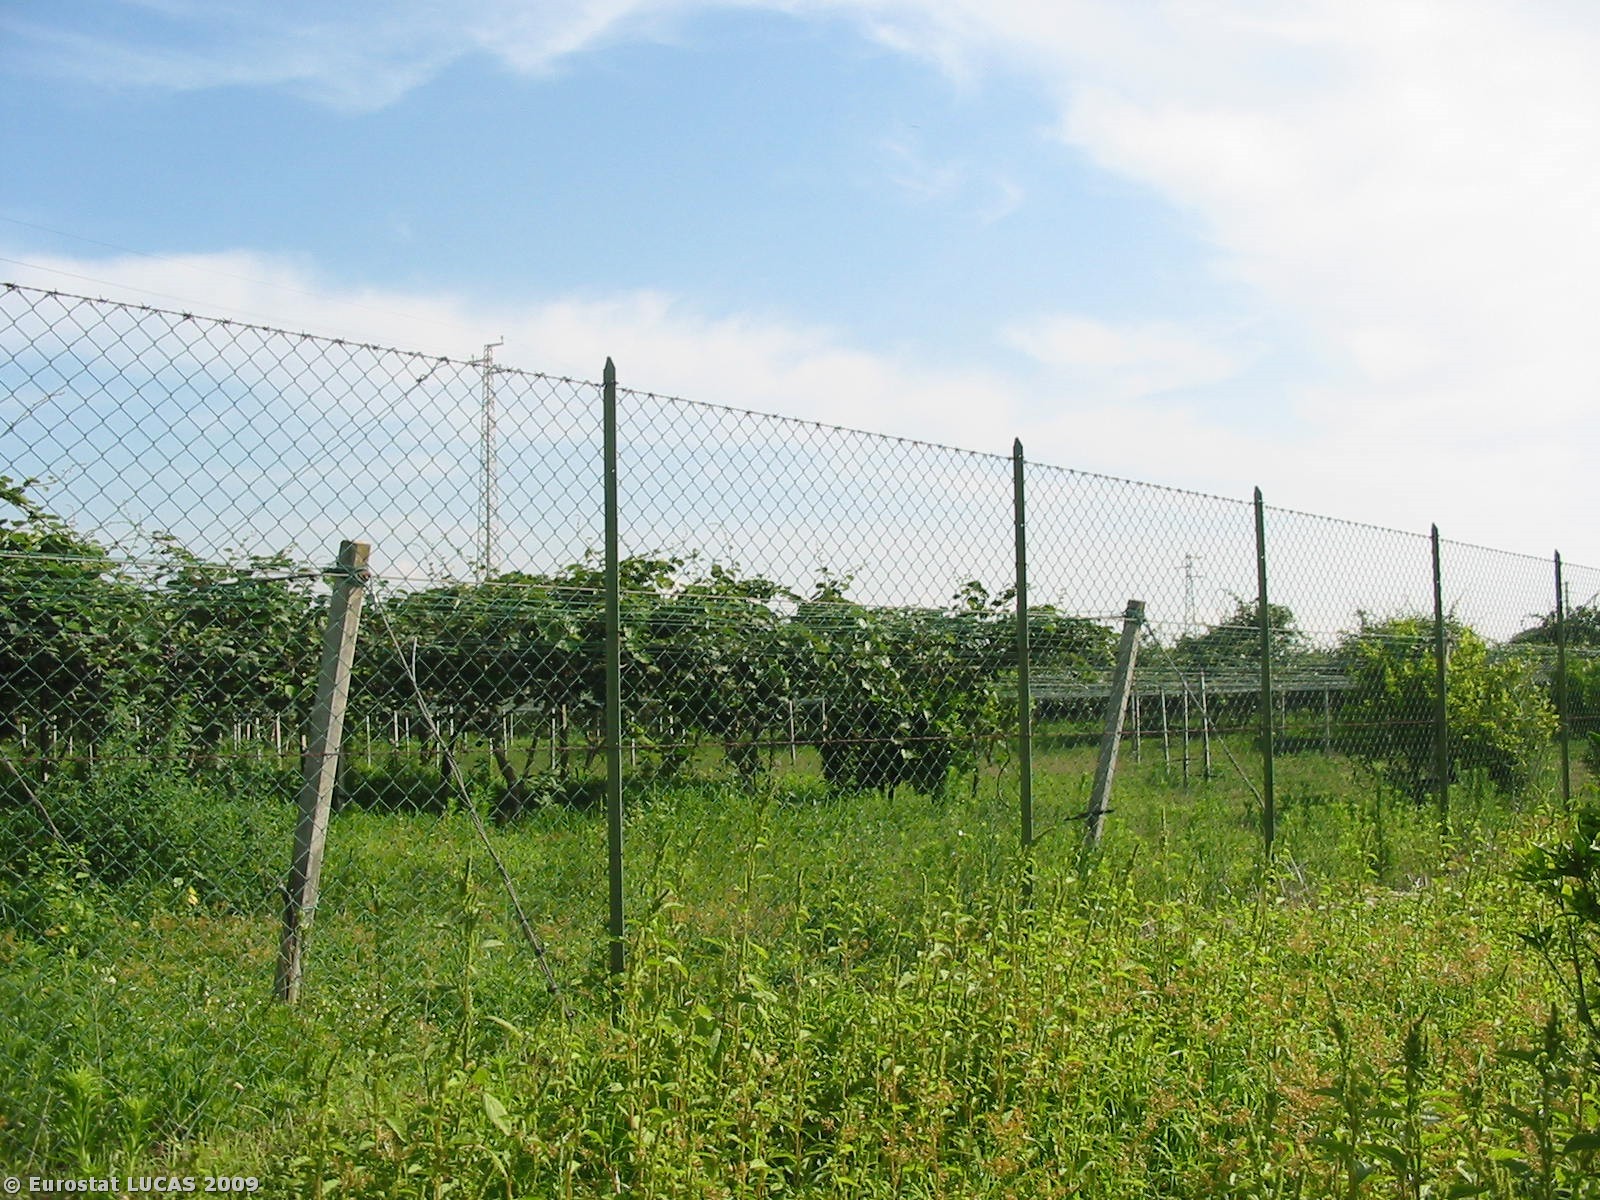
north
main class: Cropland
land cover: Other citrus fruit
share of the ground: 50 - 75 %
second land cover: Spontaneously vegetated surfaces
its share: > 75 %
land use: Agriculture (excluding fallow land and kitchen gardens)
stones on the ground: < 10 %
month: July
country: IT
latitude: 38.4517
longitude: 15.9580
